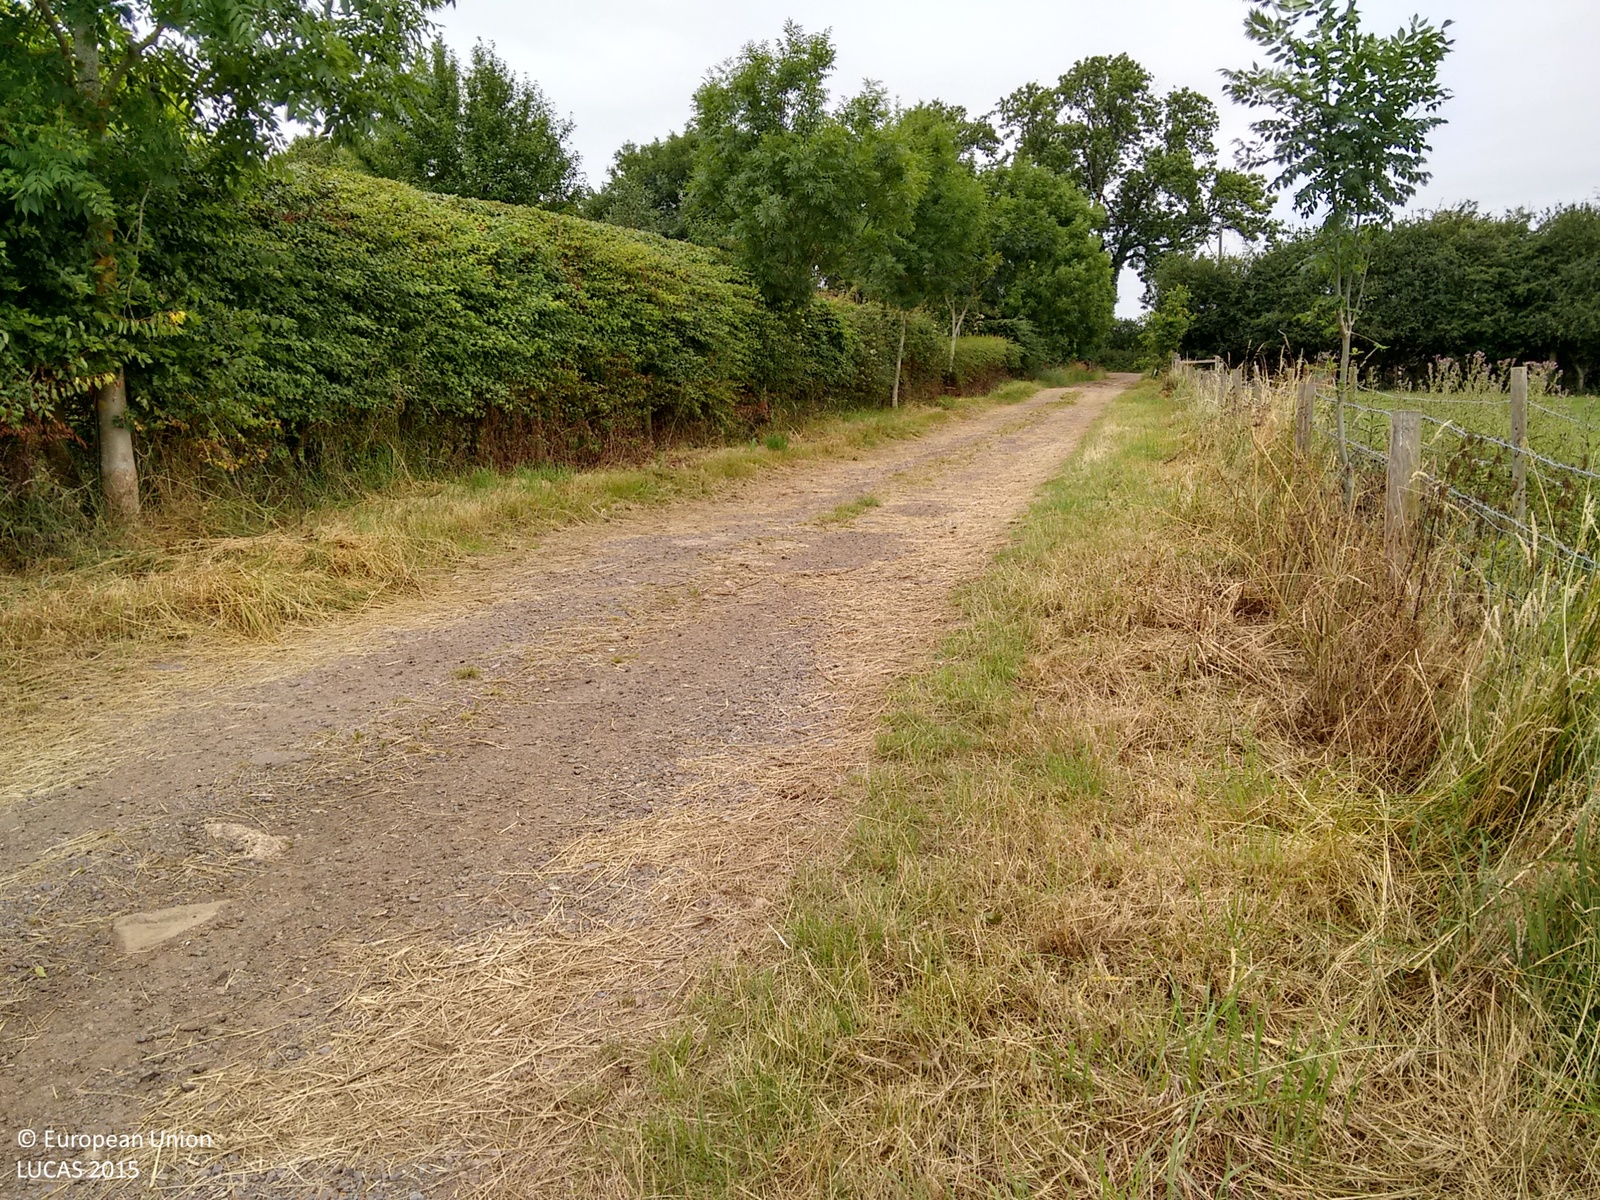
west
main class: Grassland
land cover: Grassland without tree/shrub cover
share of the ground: > 75 %
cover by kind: herbaceous plants 100 %
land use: Agriculture (excluding fallow land and kitchen gardens)
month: July
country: GB
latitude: 52.5266
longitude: -0.9062
